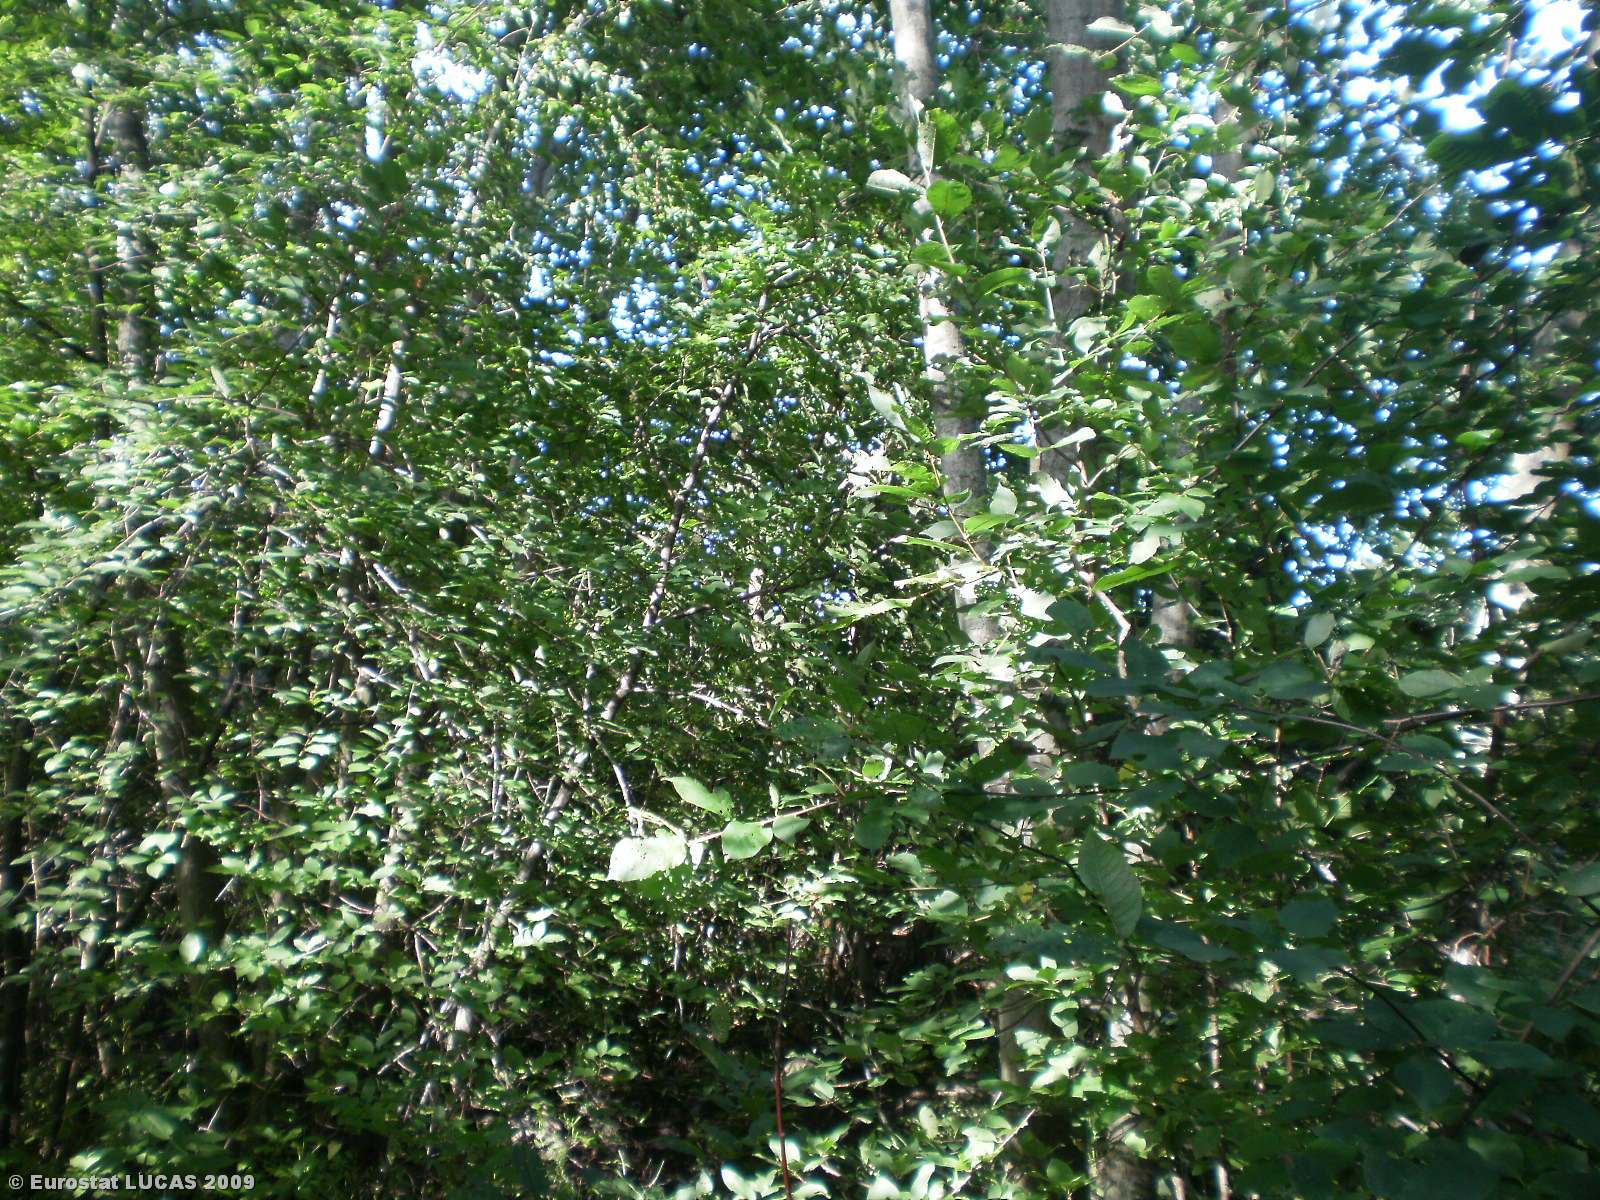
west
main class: Woodland
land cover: Broadleaved woodland
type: non-riverine alder, birch or aspen forest
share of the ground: > 75 %
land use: Forestry
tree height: > 5 m
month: July
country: LT
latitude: 55.9689
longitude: 25.8163
